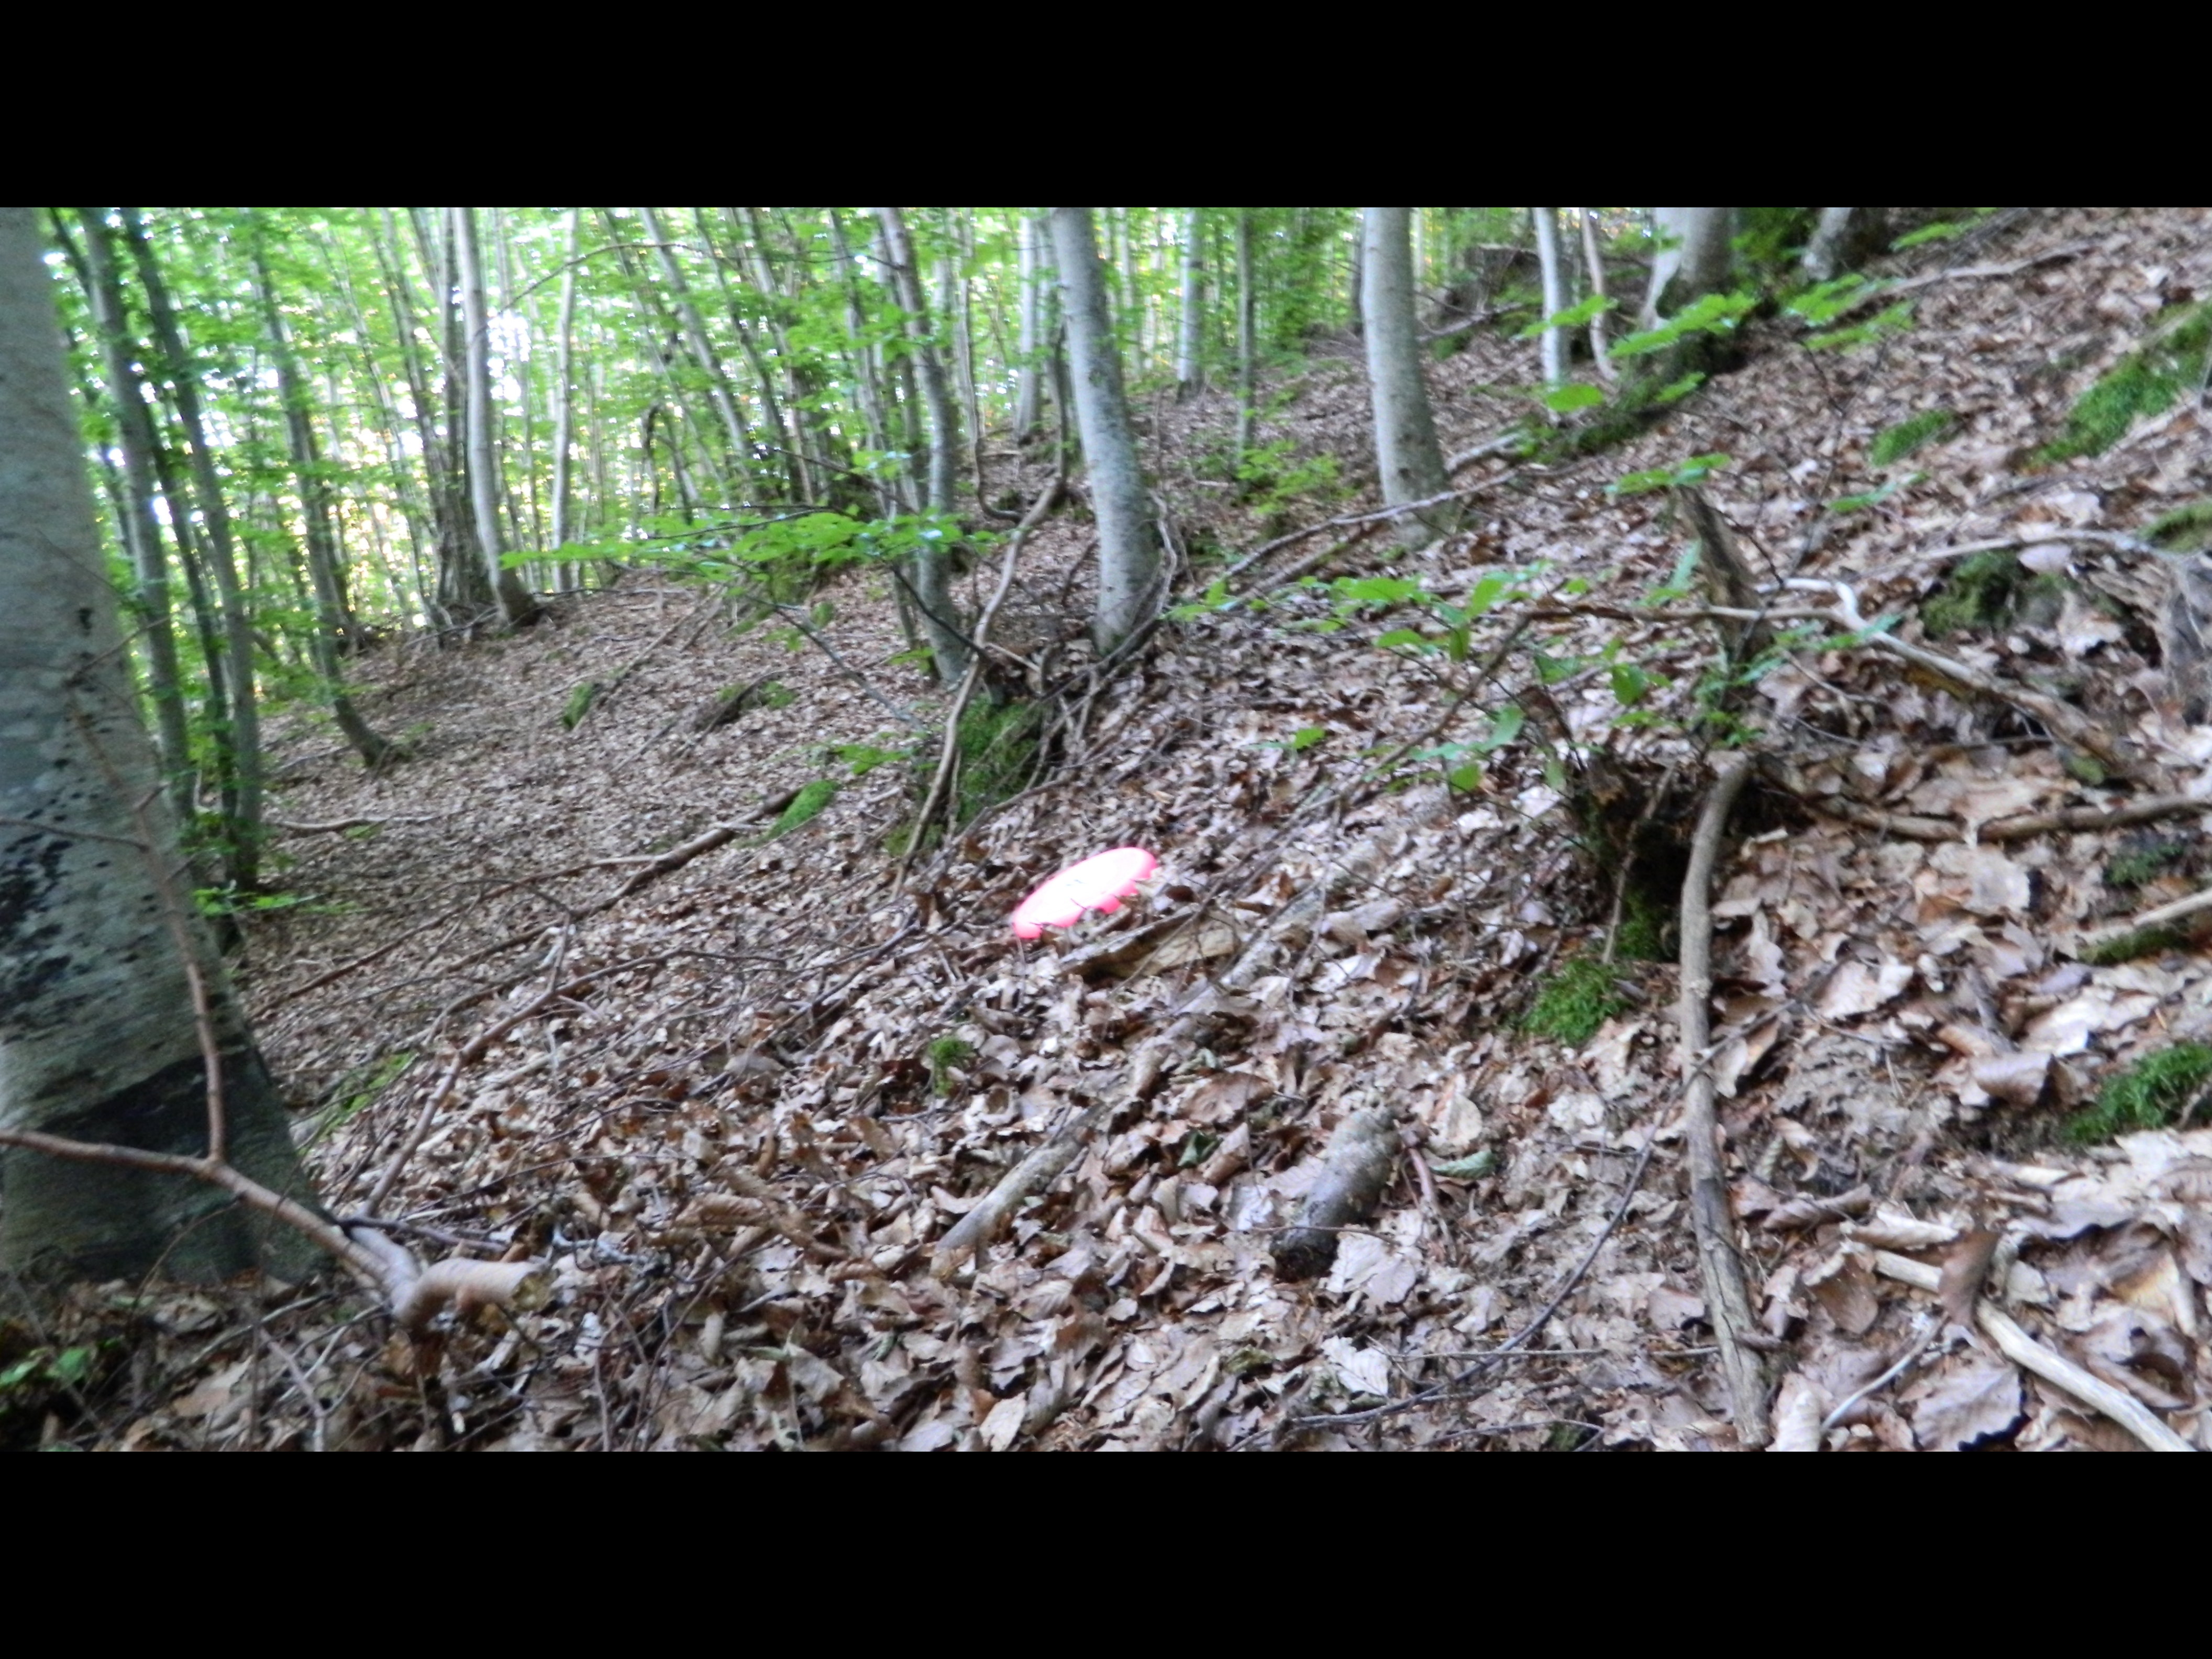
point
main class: Woodland
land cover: Broadleaved woodland
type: beech forest
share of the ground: > 75 %
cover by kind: broadleaved forest trees 100 %
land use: Forestry
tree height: > 5 m
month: July
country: BG
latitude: 41.6191
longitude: 24.8935
